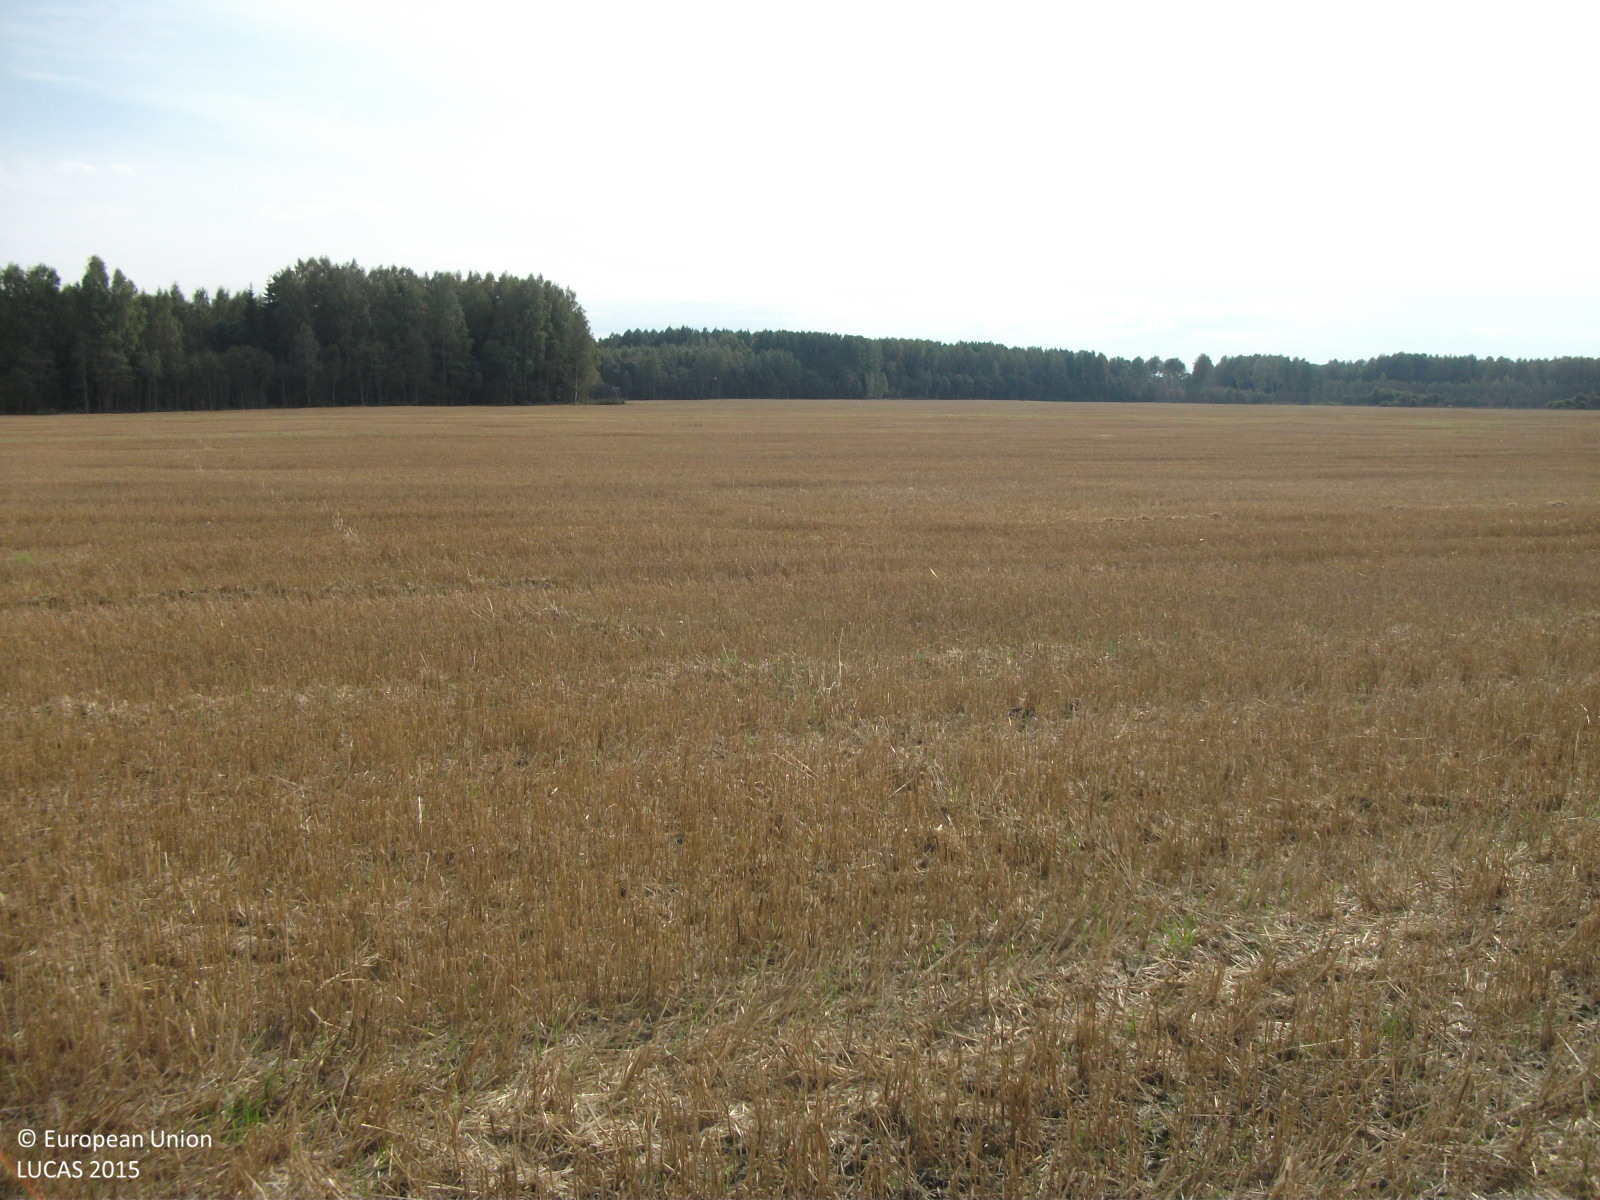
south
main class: Cropland
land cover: Common wheat
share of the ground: < 10 %
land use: Agriculture (excluding fallow land and kitchen gardens)
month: September
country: LV
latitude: 57.7073
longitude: 24.7810
